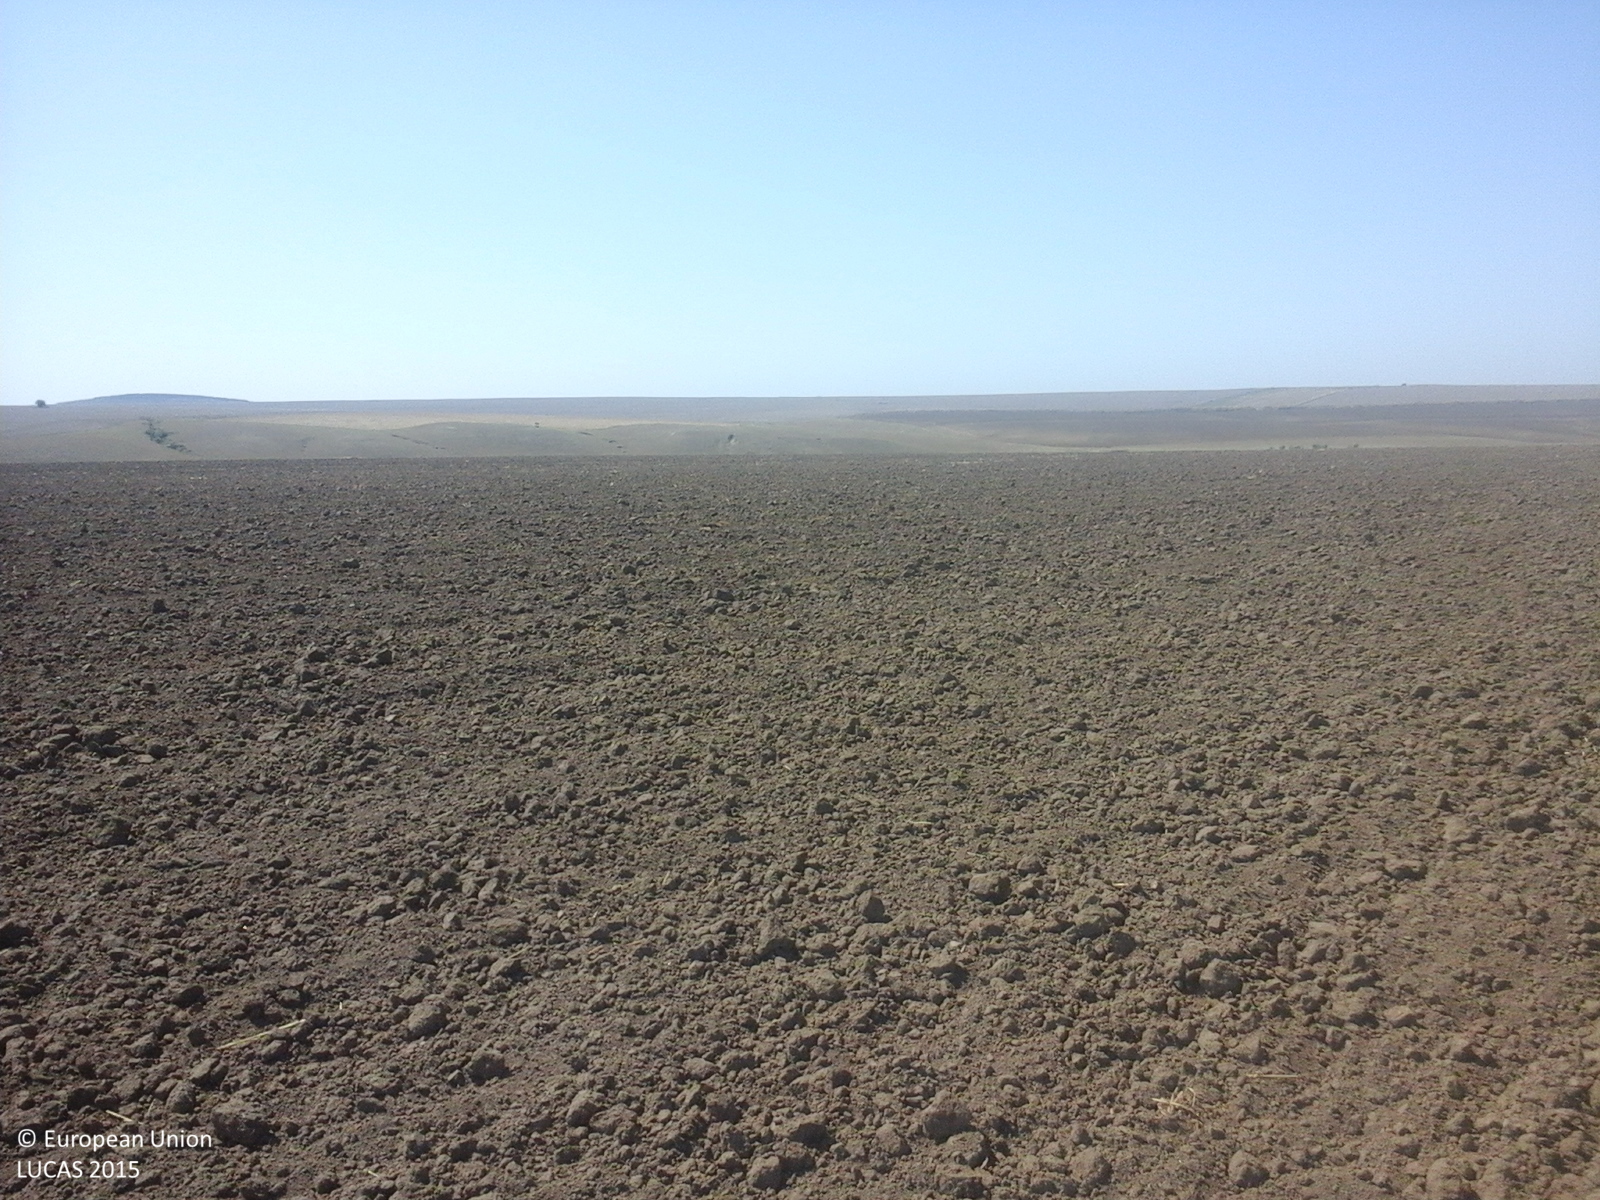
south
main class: Cropland
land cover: Barley
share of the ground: < 10 %
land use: Agriculture (excluding fallow land and kitchen gardens)
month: August
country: RO
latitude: 44.6159
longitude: 28.1468
